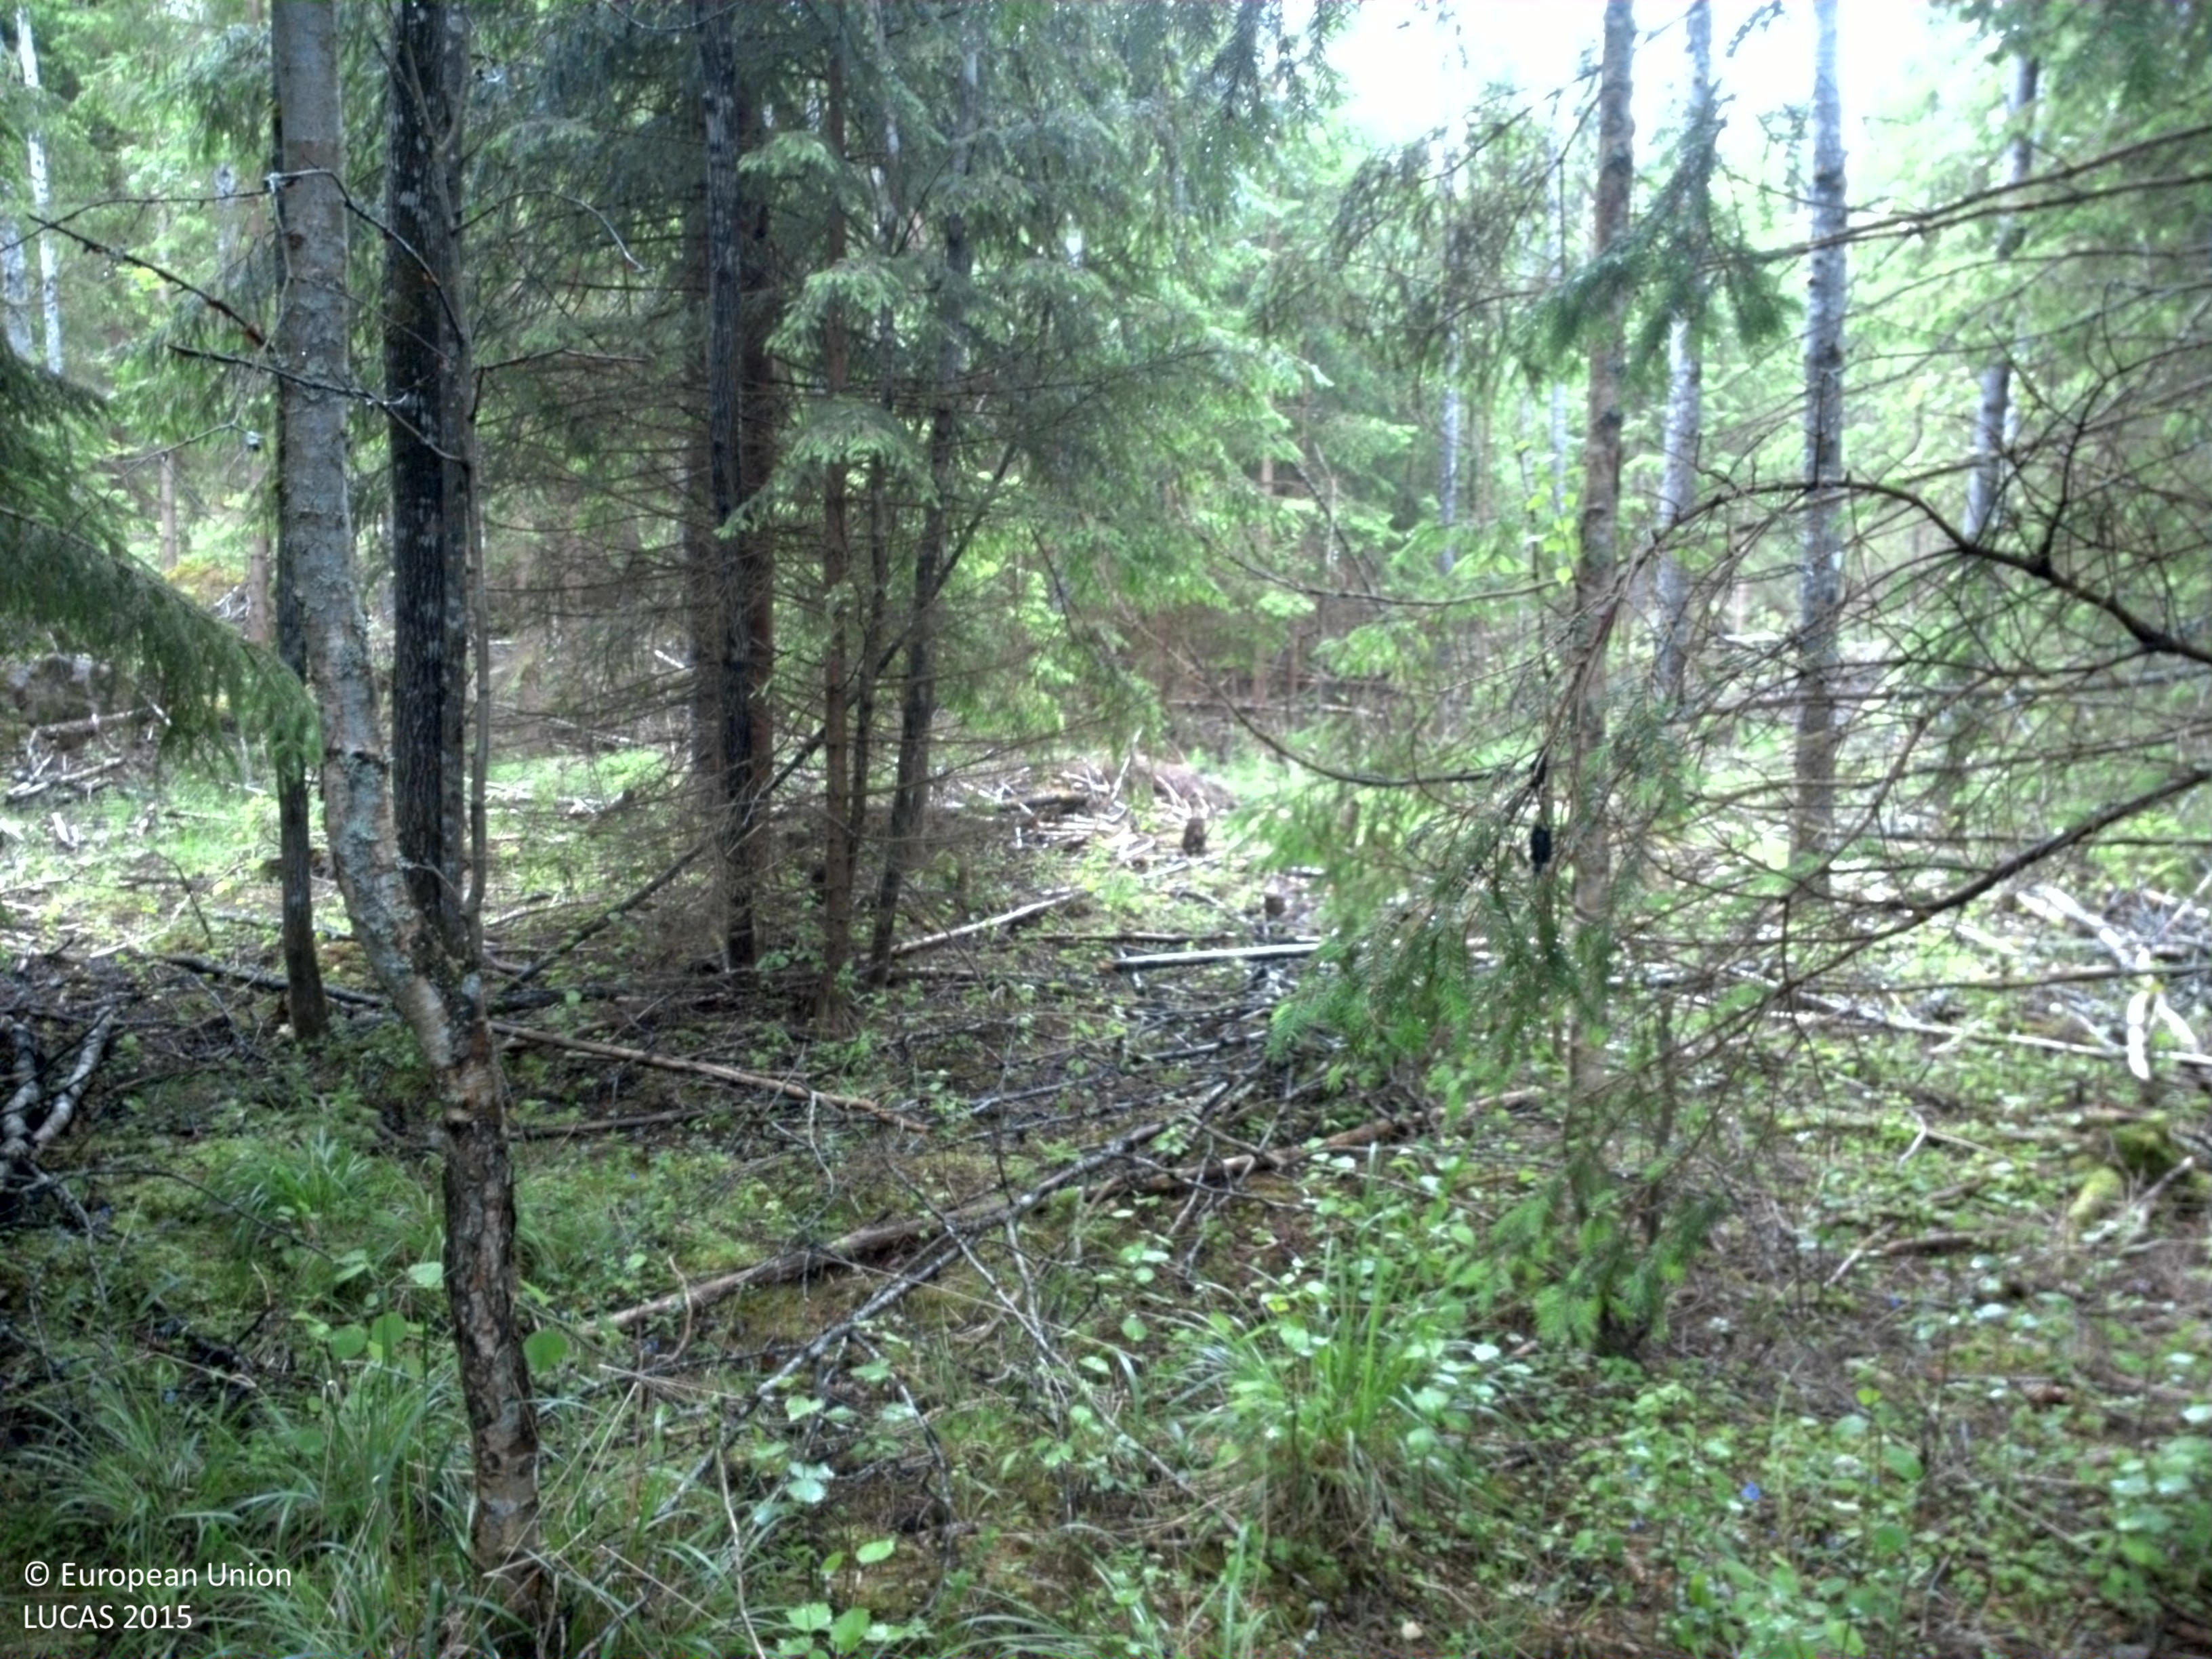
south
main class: Woodland
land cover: Spruce dominated mixed woodland
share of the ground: 50 - 75 %
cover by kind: coniferous forest trees 40 %, herbaceous plants 30 %, broadleaved forest trees 20 %, lichens and mosses 10 %
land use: Forestry
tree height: > 5 m
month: June
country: SE
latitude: 58.5848
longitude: 15.7220
